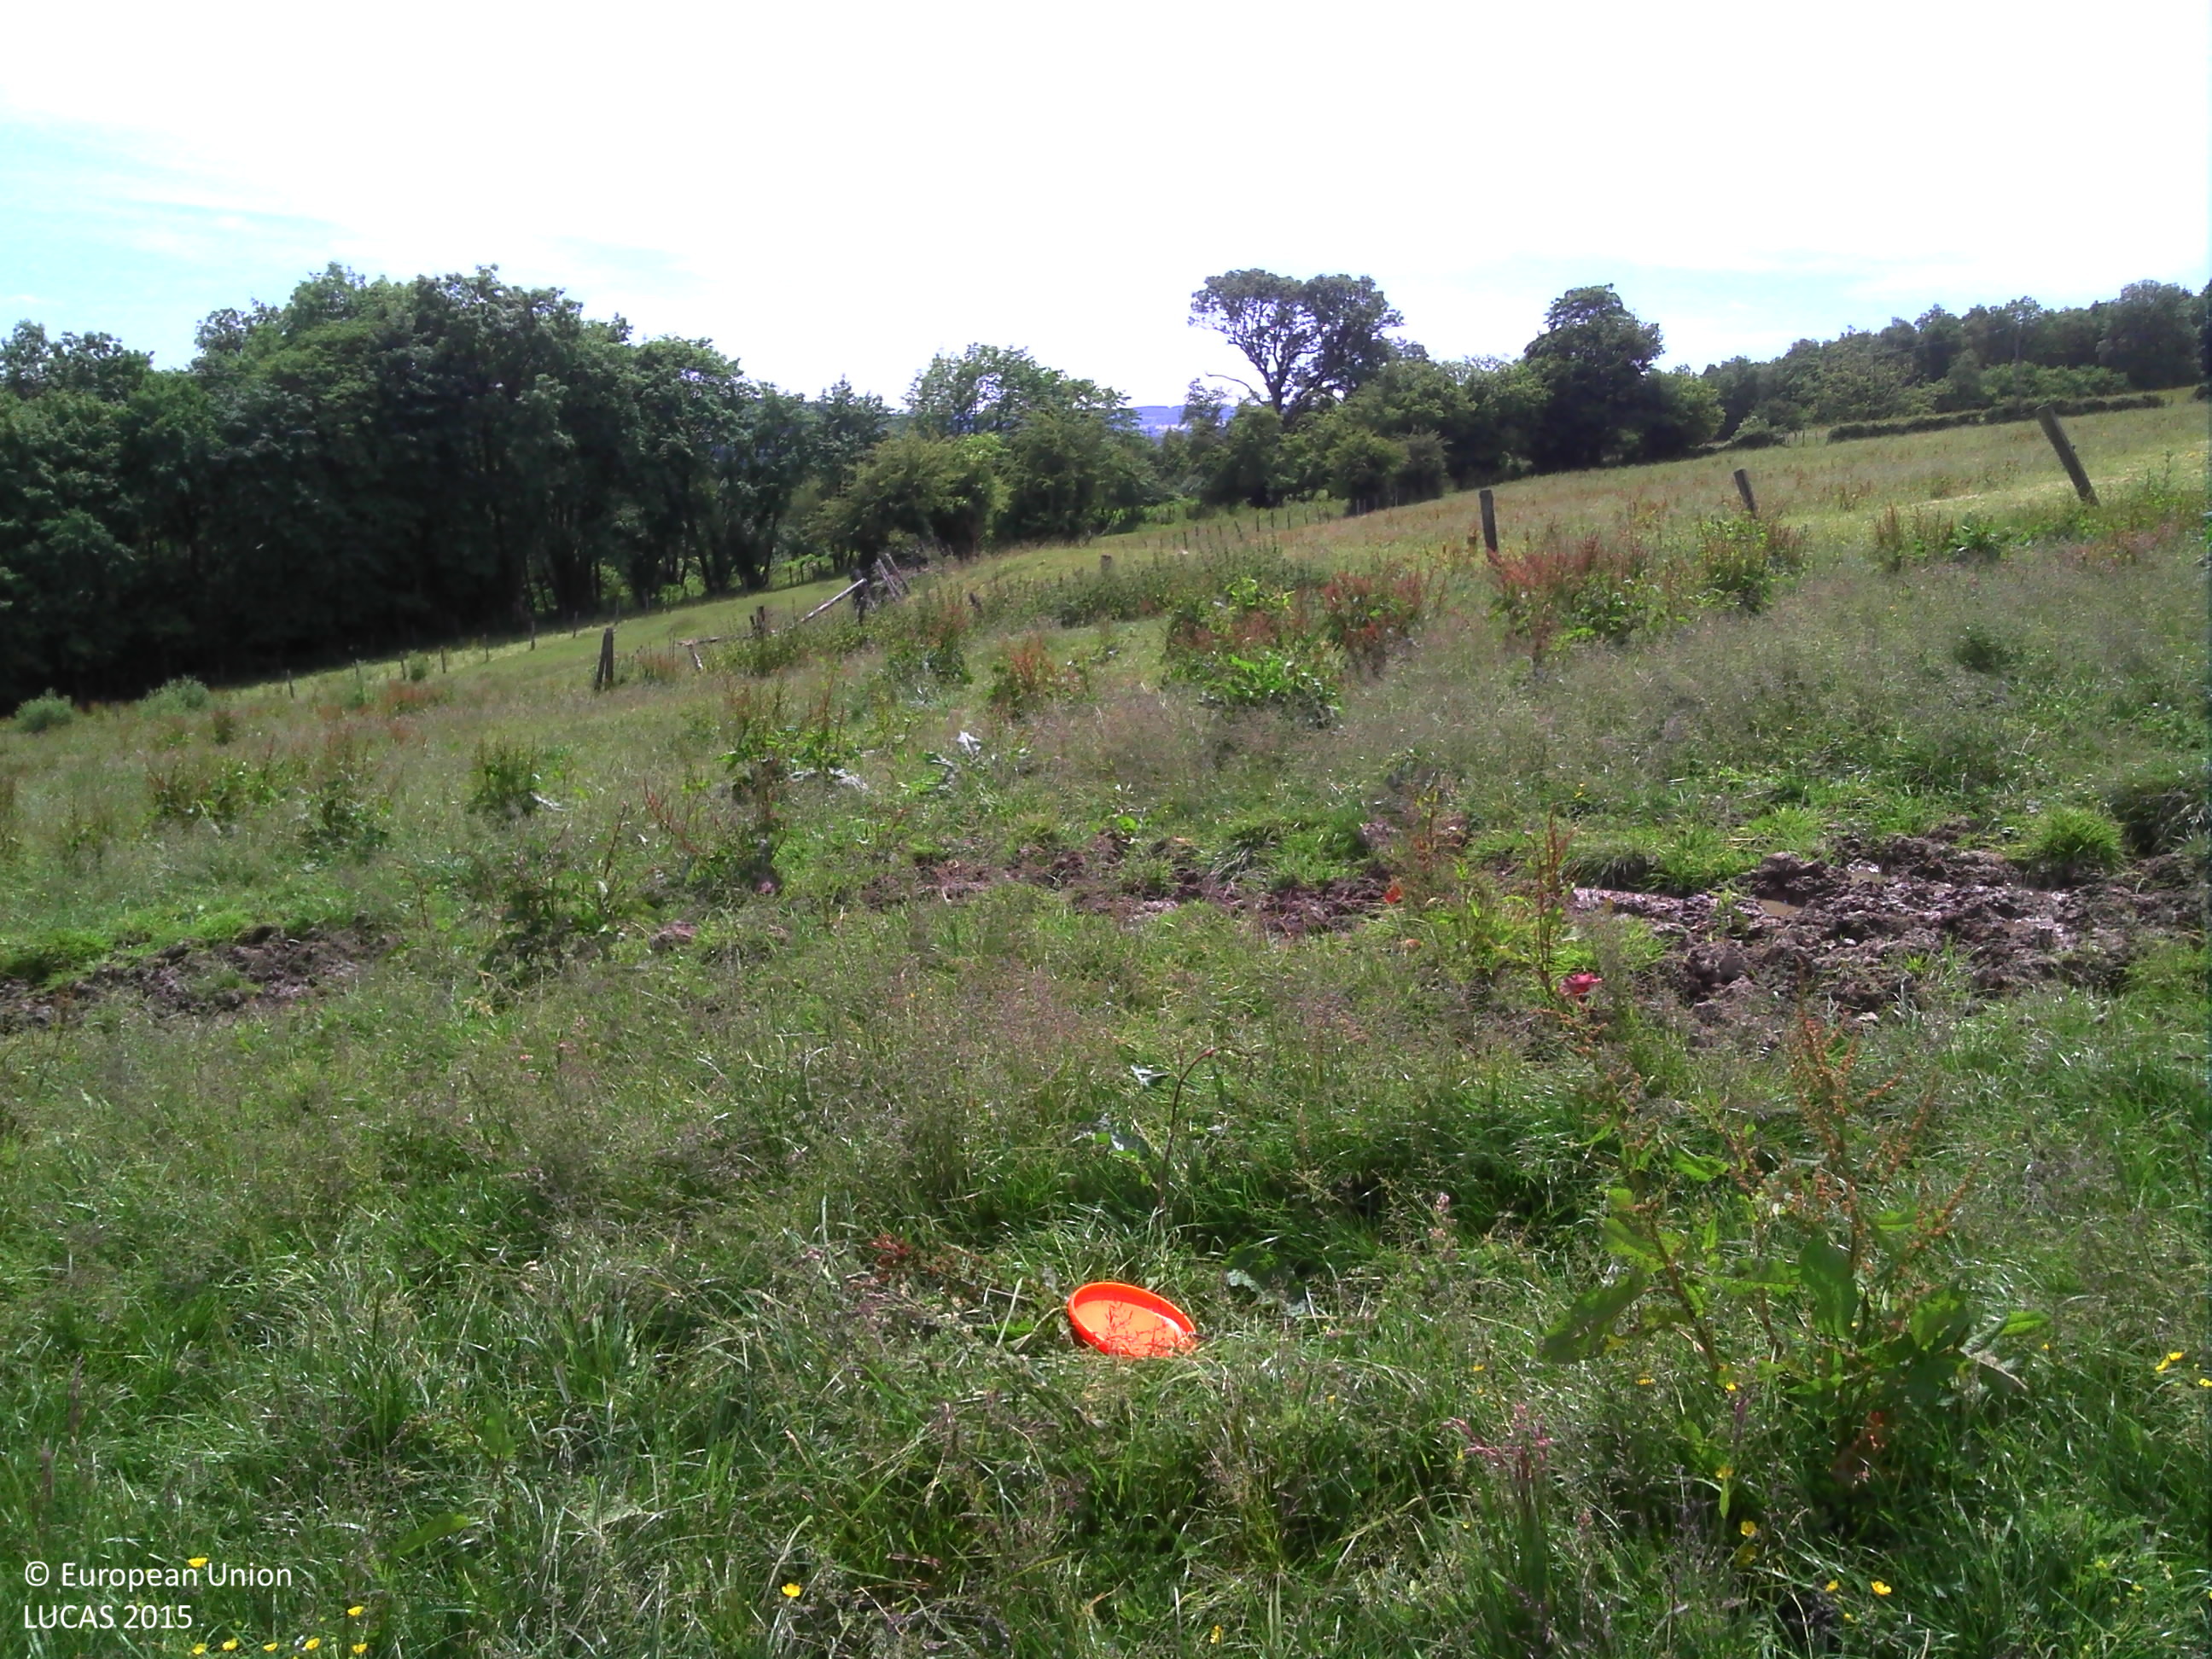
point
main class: Grassland
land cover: Grassland without tree/shrub cover
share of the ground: > 75 %
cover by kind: herbaceous plants 100 %
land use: Agriculture (excluding fallow land and kitchen gardens)
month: June
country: BE
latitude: 50.4337
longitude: 5.8738
